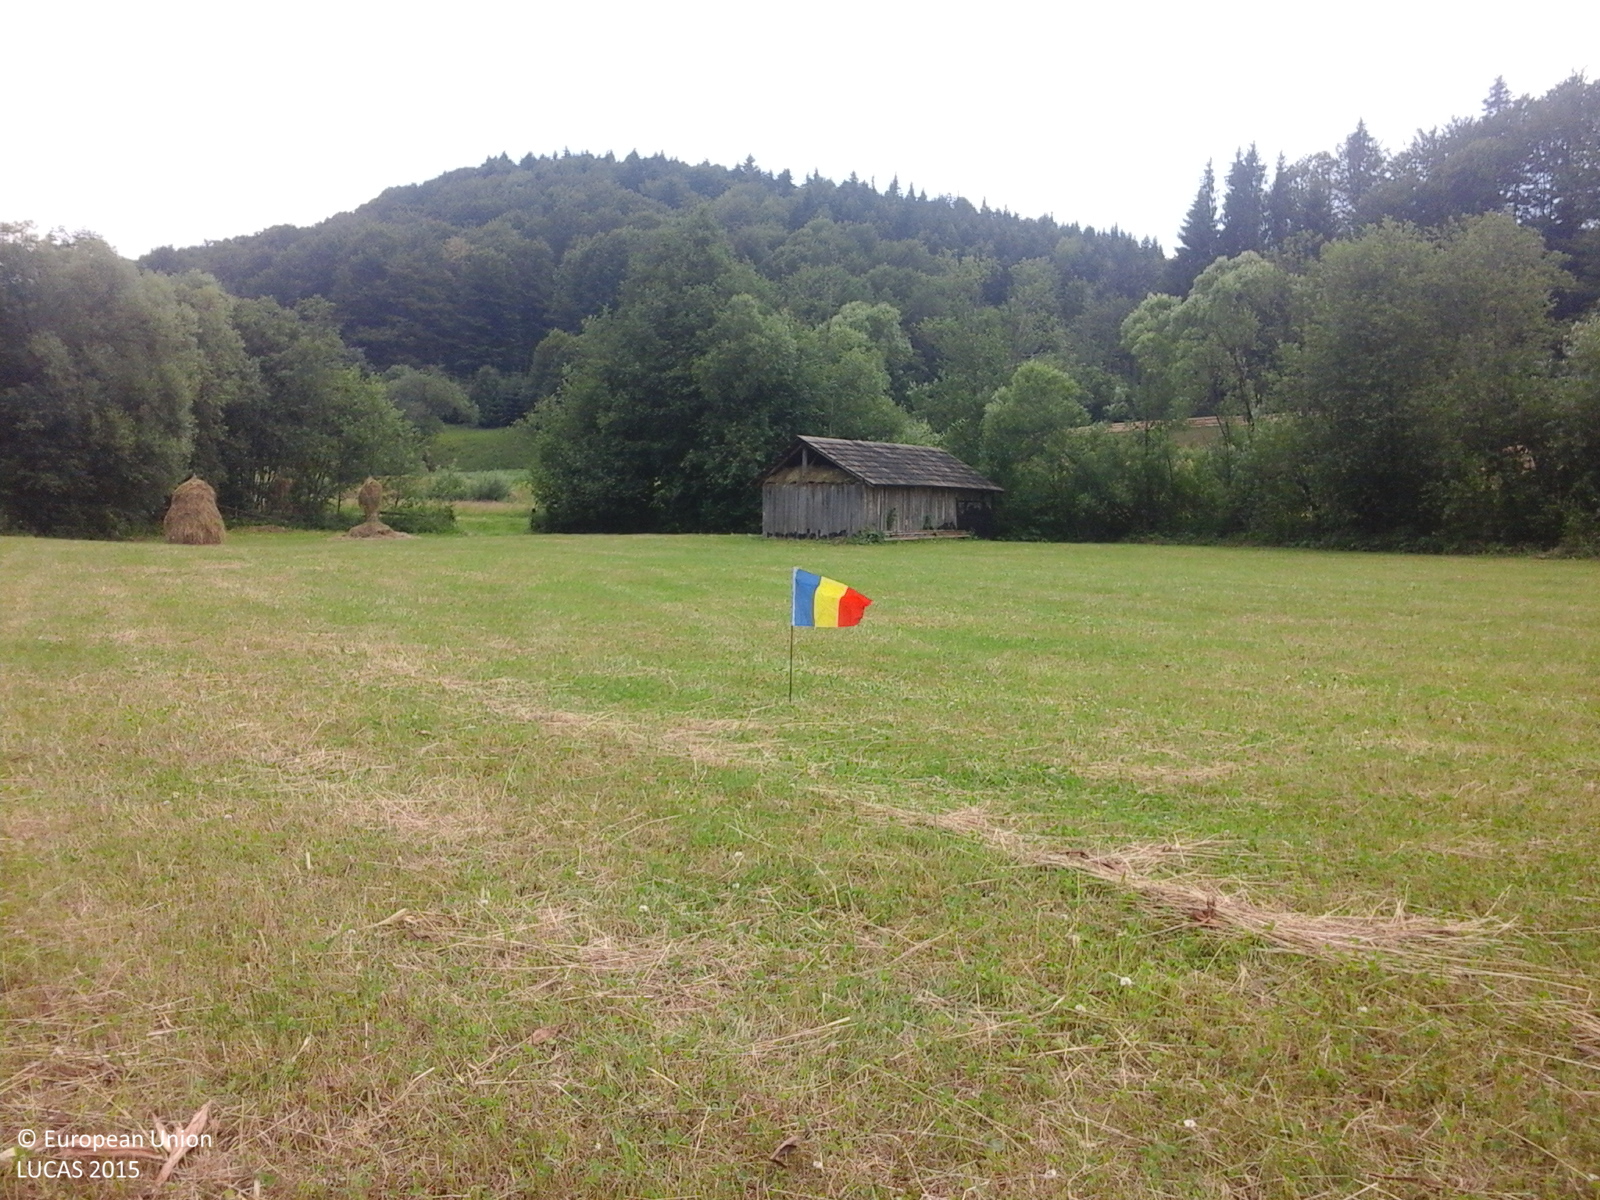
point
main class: Grassland
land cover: Grassland without tree/shrub cover
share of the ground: > 75 %
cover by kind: herbaceous plants 100 %
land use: Agriculture (excluding fallow land and kitchen gardens)
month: June
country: RO
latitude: 47.6228
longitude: 25.8127
